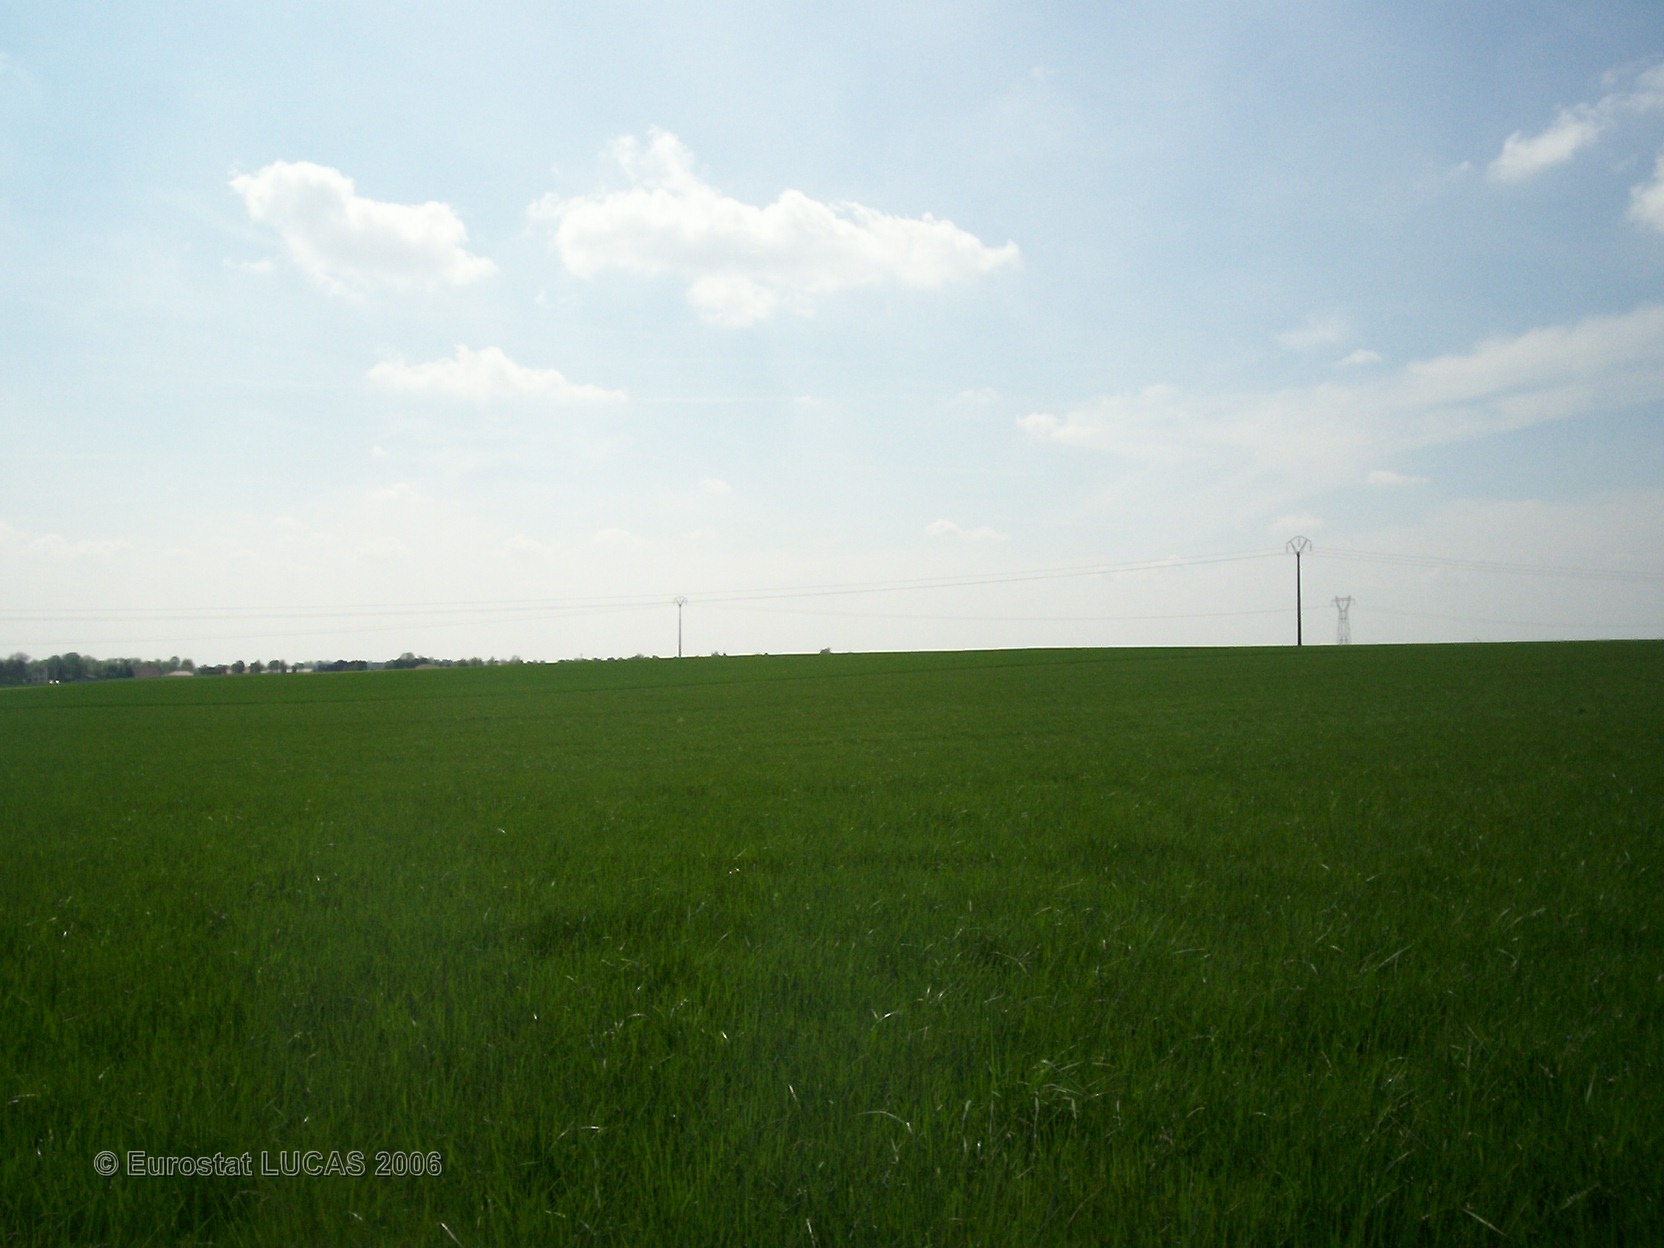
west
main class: Cropland
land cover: Common wheat
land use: Agriculture (excluding fallow land and kitchen gardens)
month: May
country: FR
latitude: 48.9130
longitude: 4.4431
